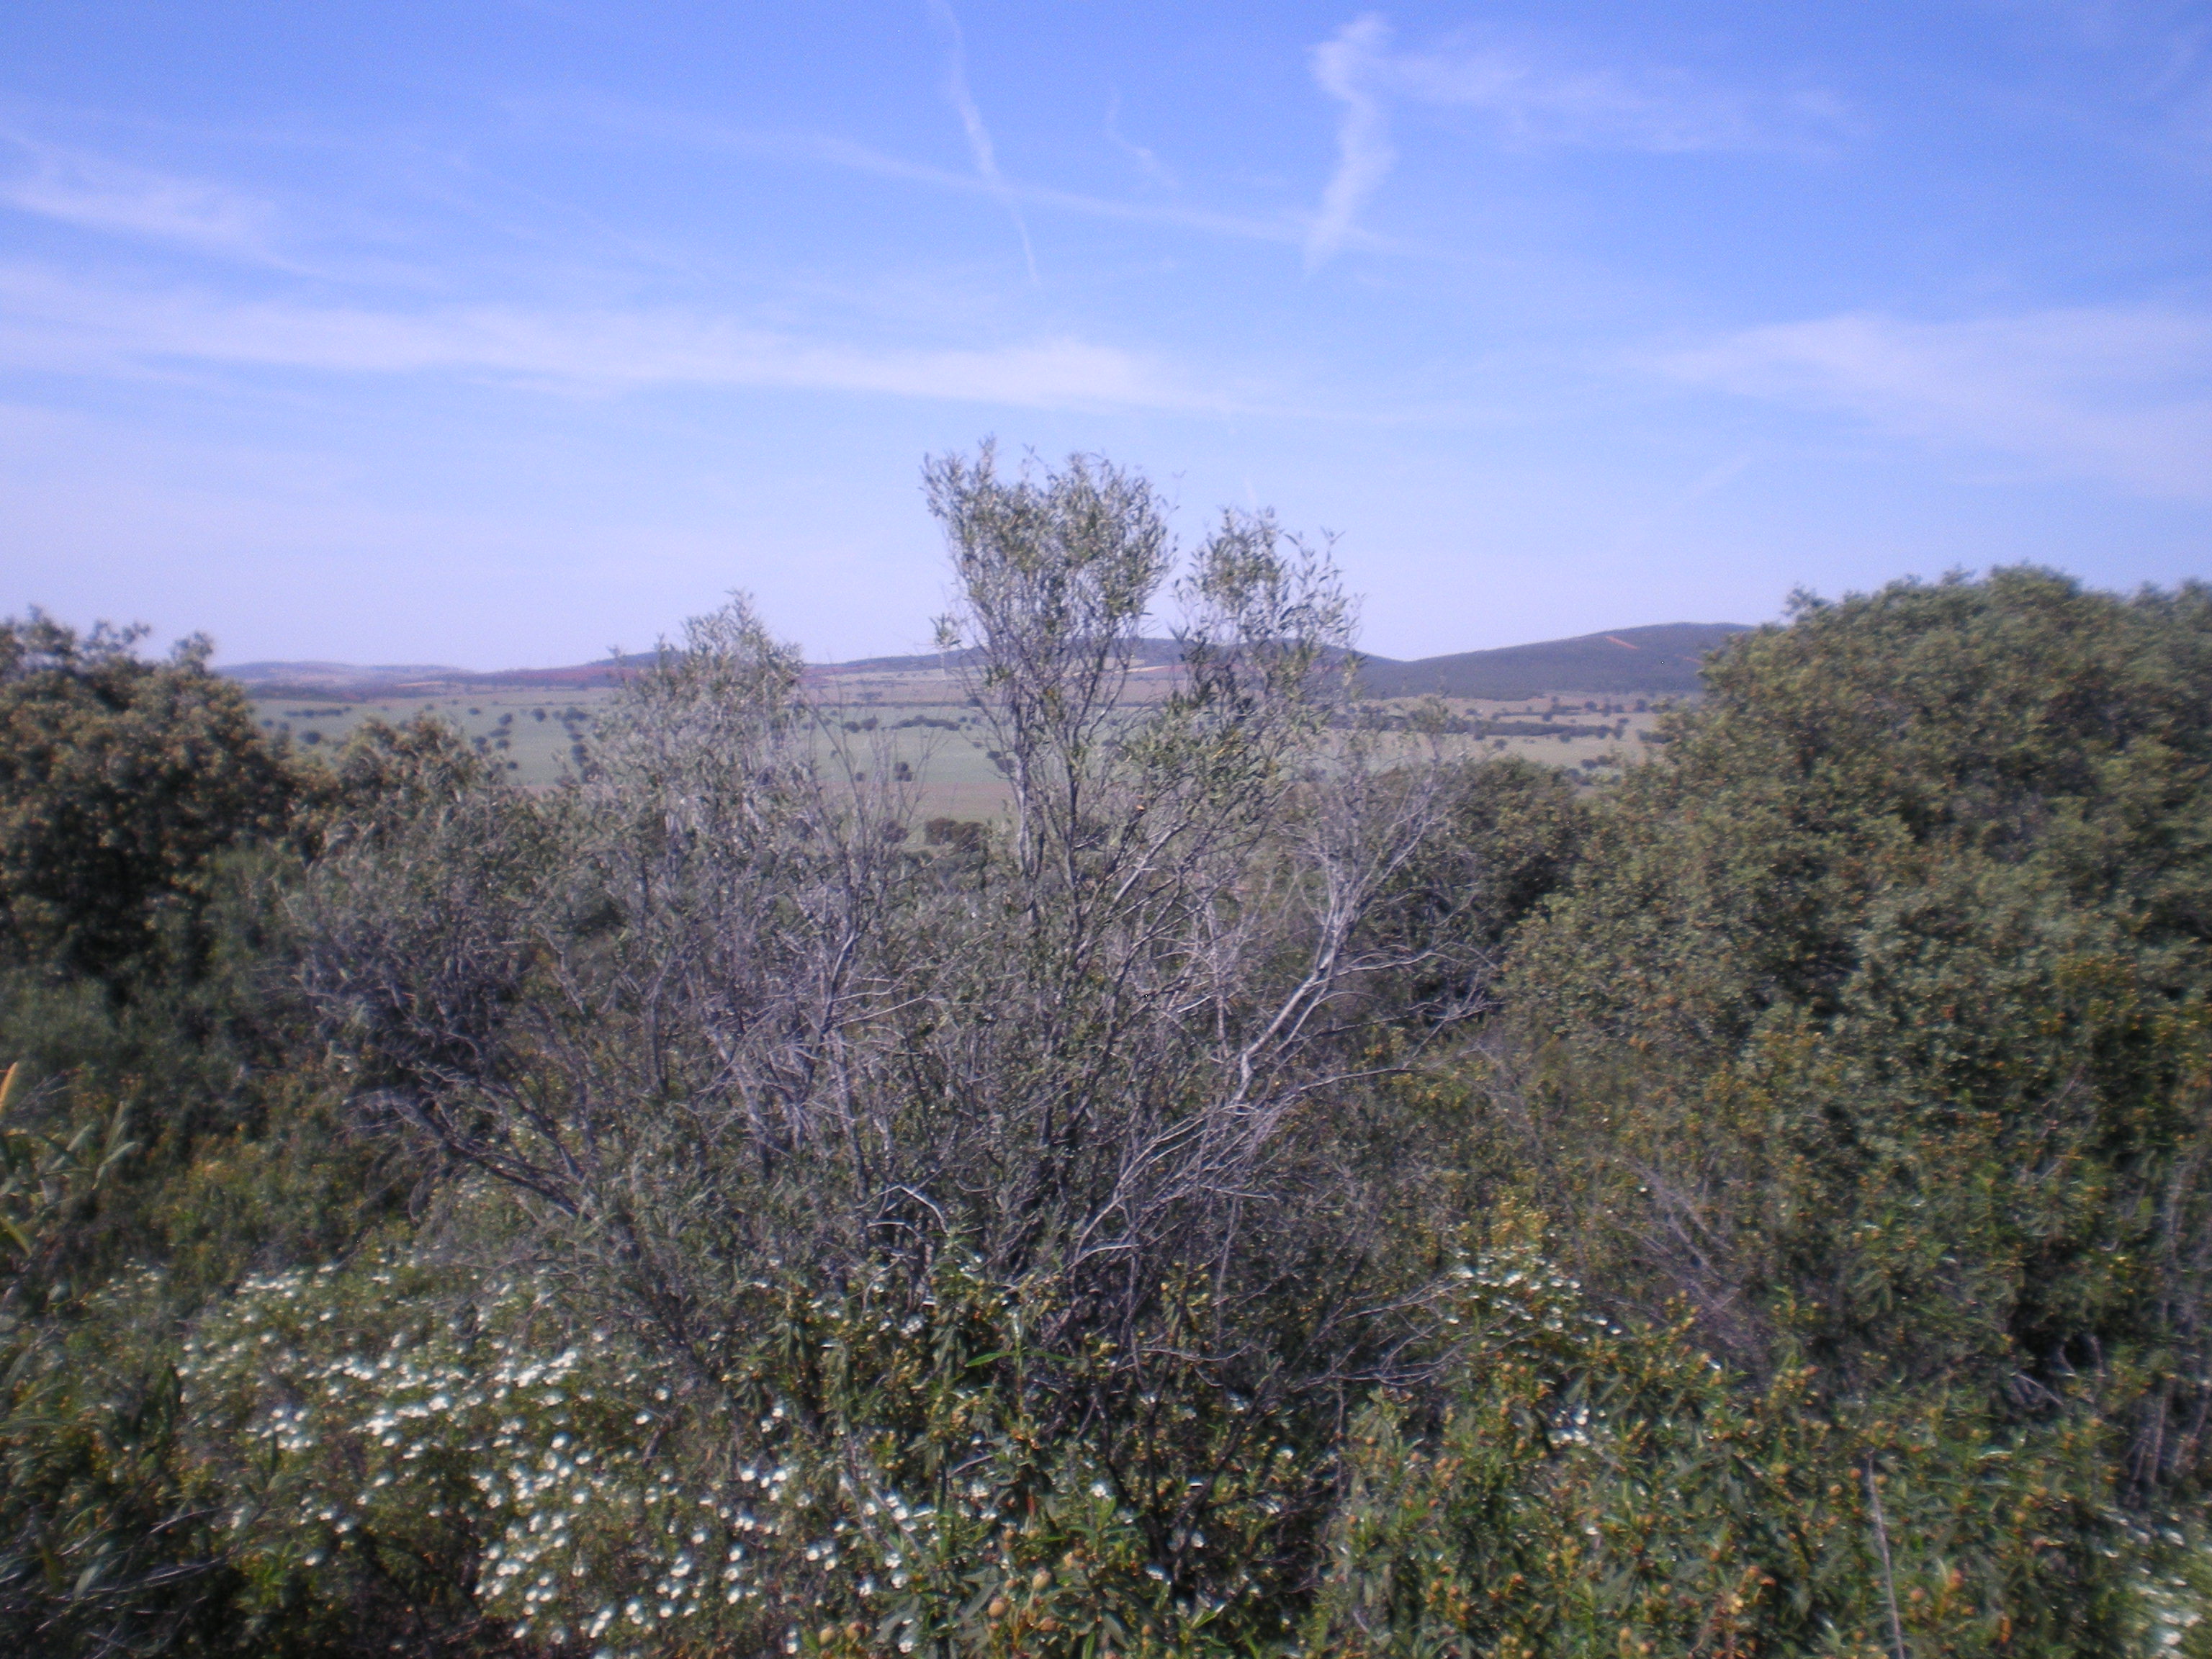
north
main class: Shrubland
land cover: Shrubland with sparse tree cover
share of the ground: > 75 %
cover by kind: shrubs 80 %, herbaceous plants 10 %, broadleaved forest trees 5 %, unconsolidated bare surface 5 %
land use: Other primary production
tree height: < 5 m
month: May
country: ES
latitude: 38.5283
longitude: -3.4638
